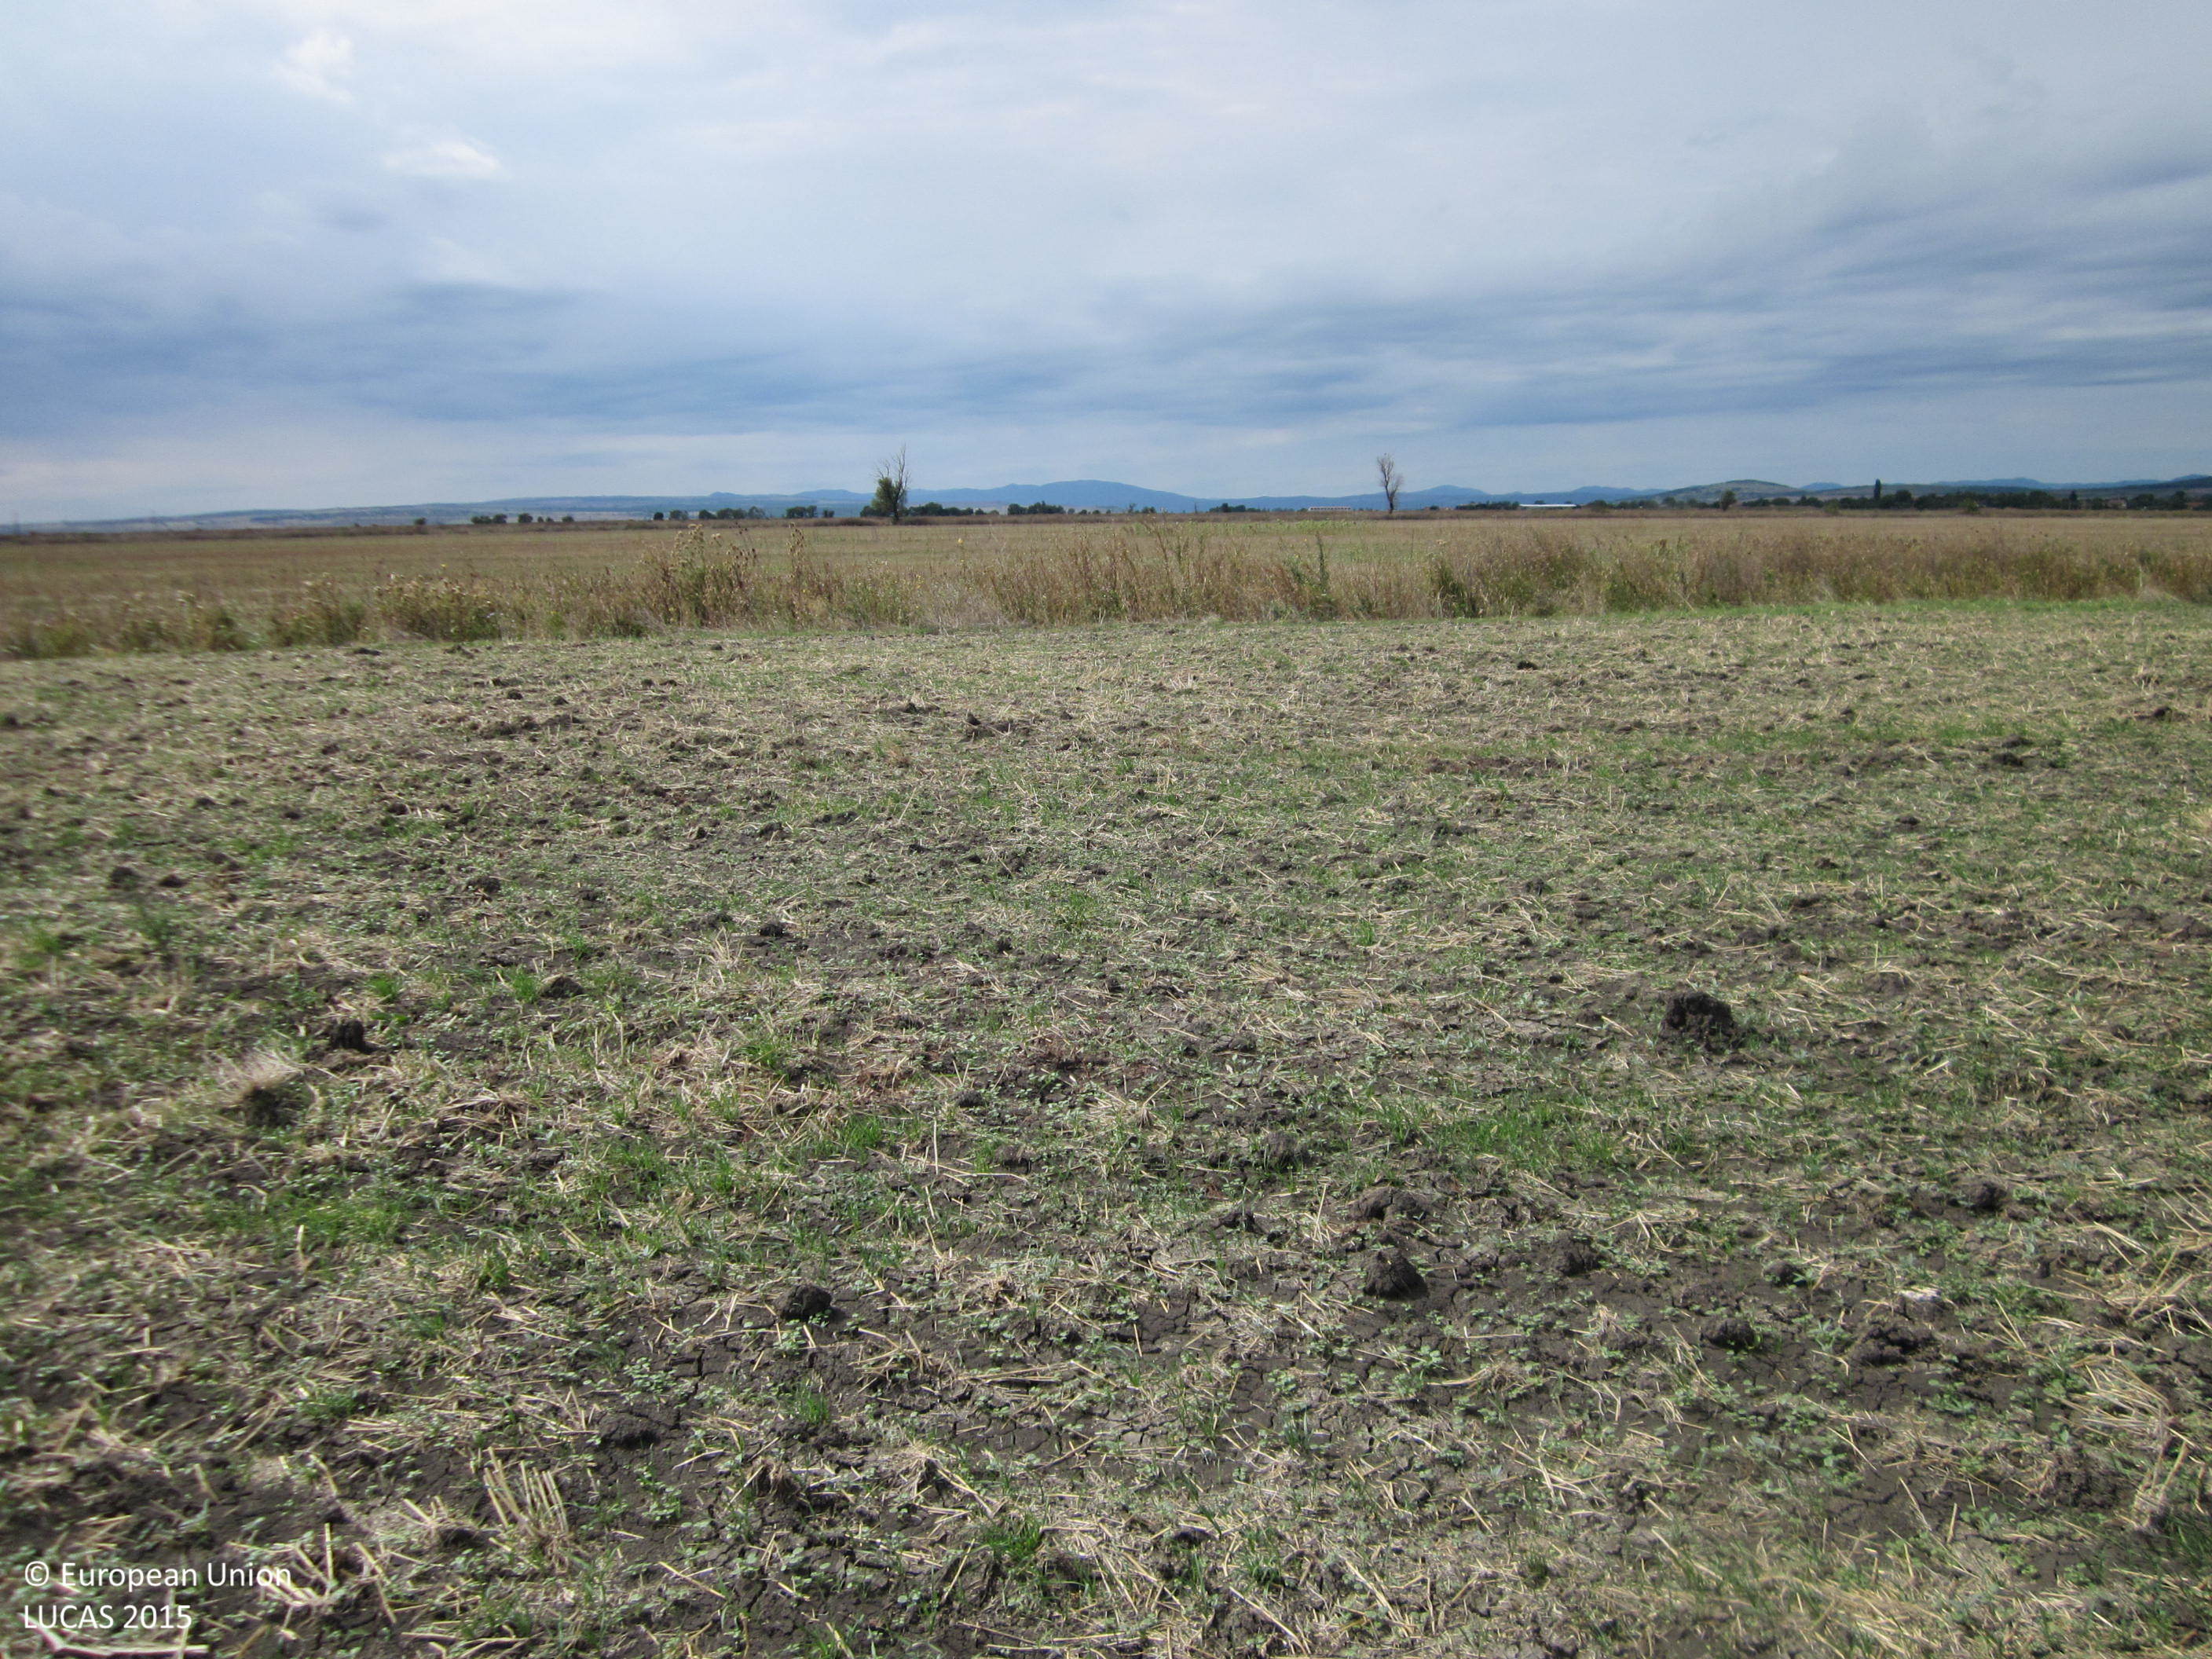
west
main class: Cropland
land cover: Common wheat
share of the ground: 10 - 25 %
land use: Agriculture (excluding fallow land and kitchen gardens)
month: September
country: BG
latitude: 42.6977
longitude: 26.9894
